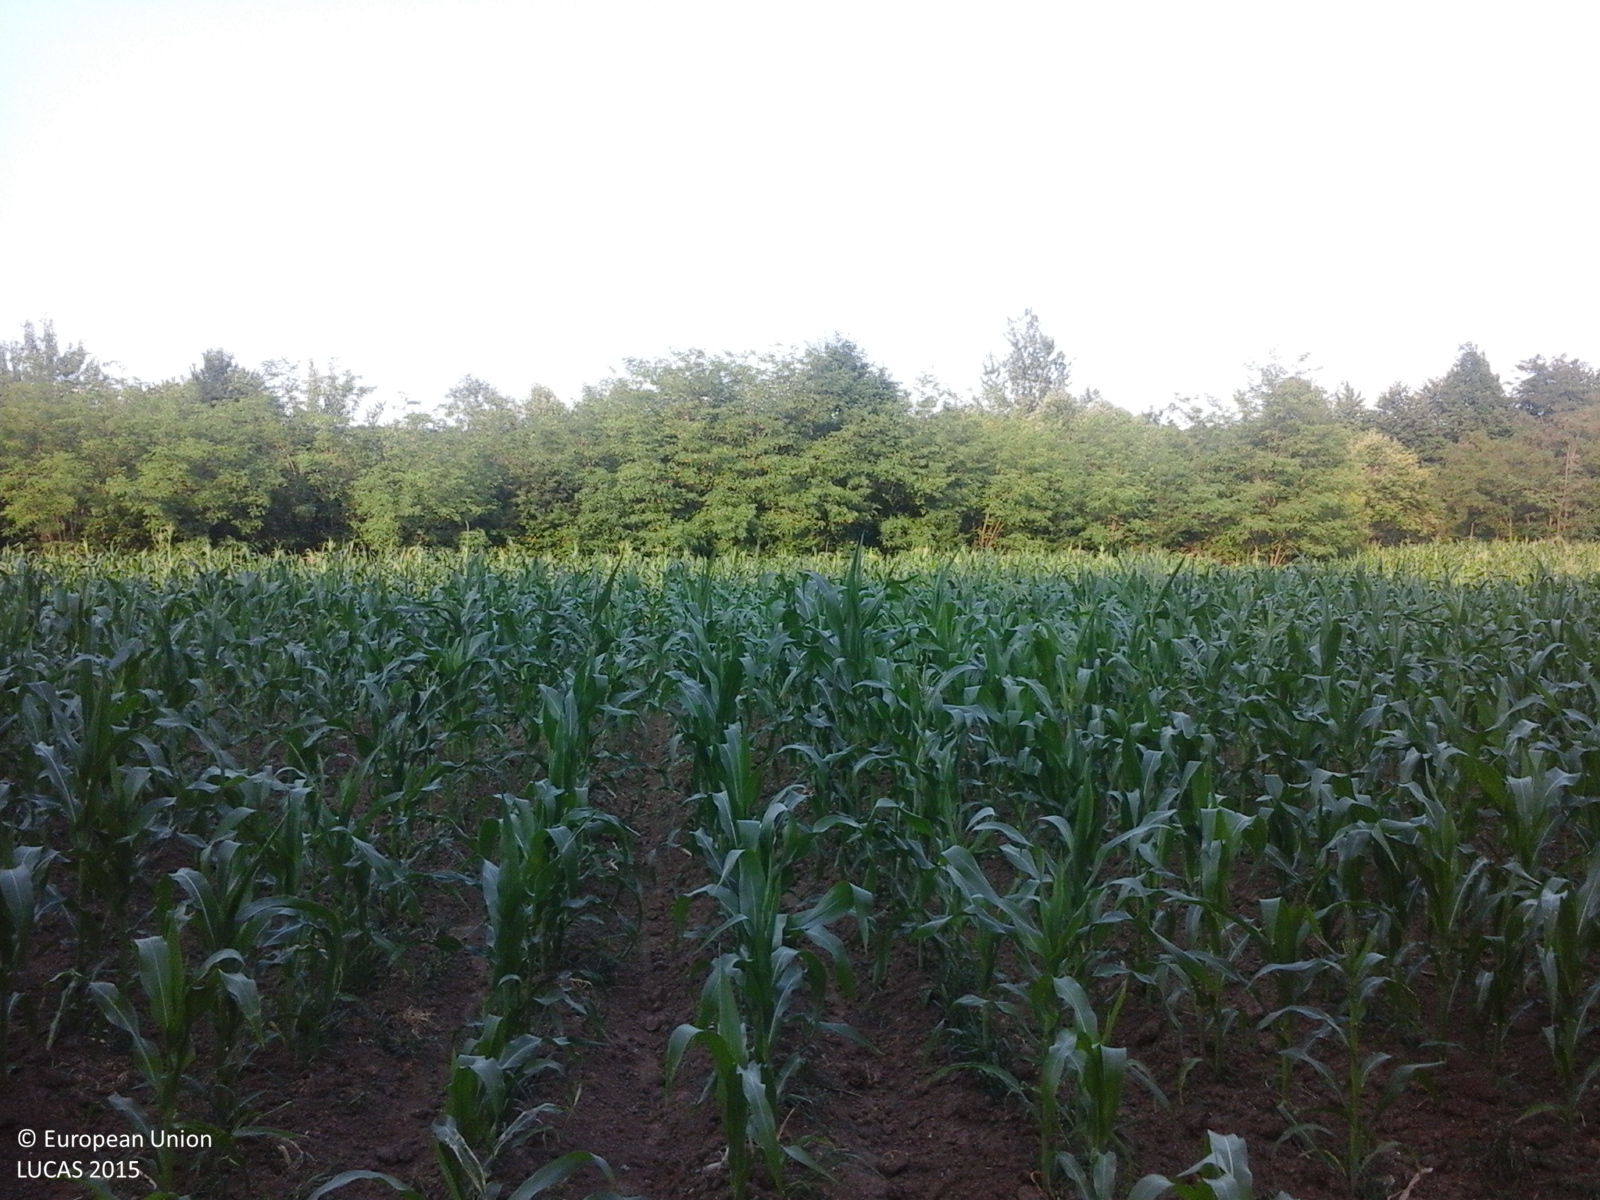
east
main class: Cropland
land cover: Maize
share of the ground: > 75 %
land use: Agriculture (excluding fallow land and kitchen gardens)
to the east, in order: Tracks; Maize; Broadleaved woodland; Inland fresh running water; Broadleaved woodland; Common wheat
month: July
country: RO
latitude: 44.8081
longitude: 24.7583
